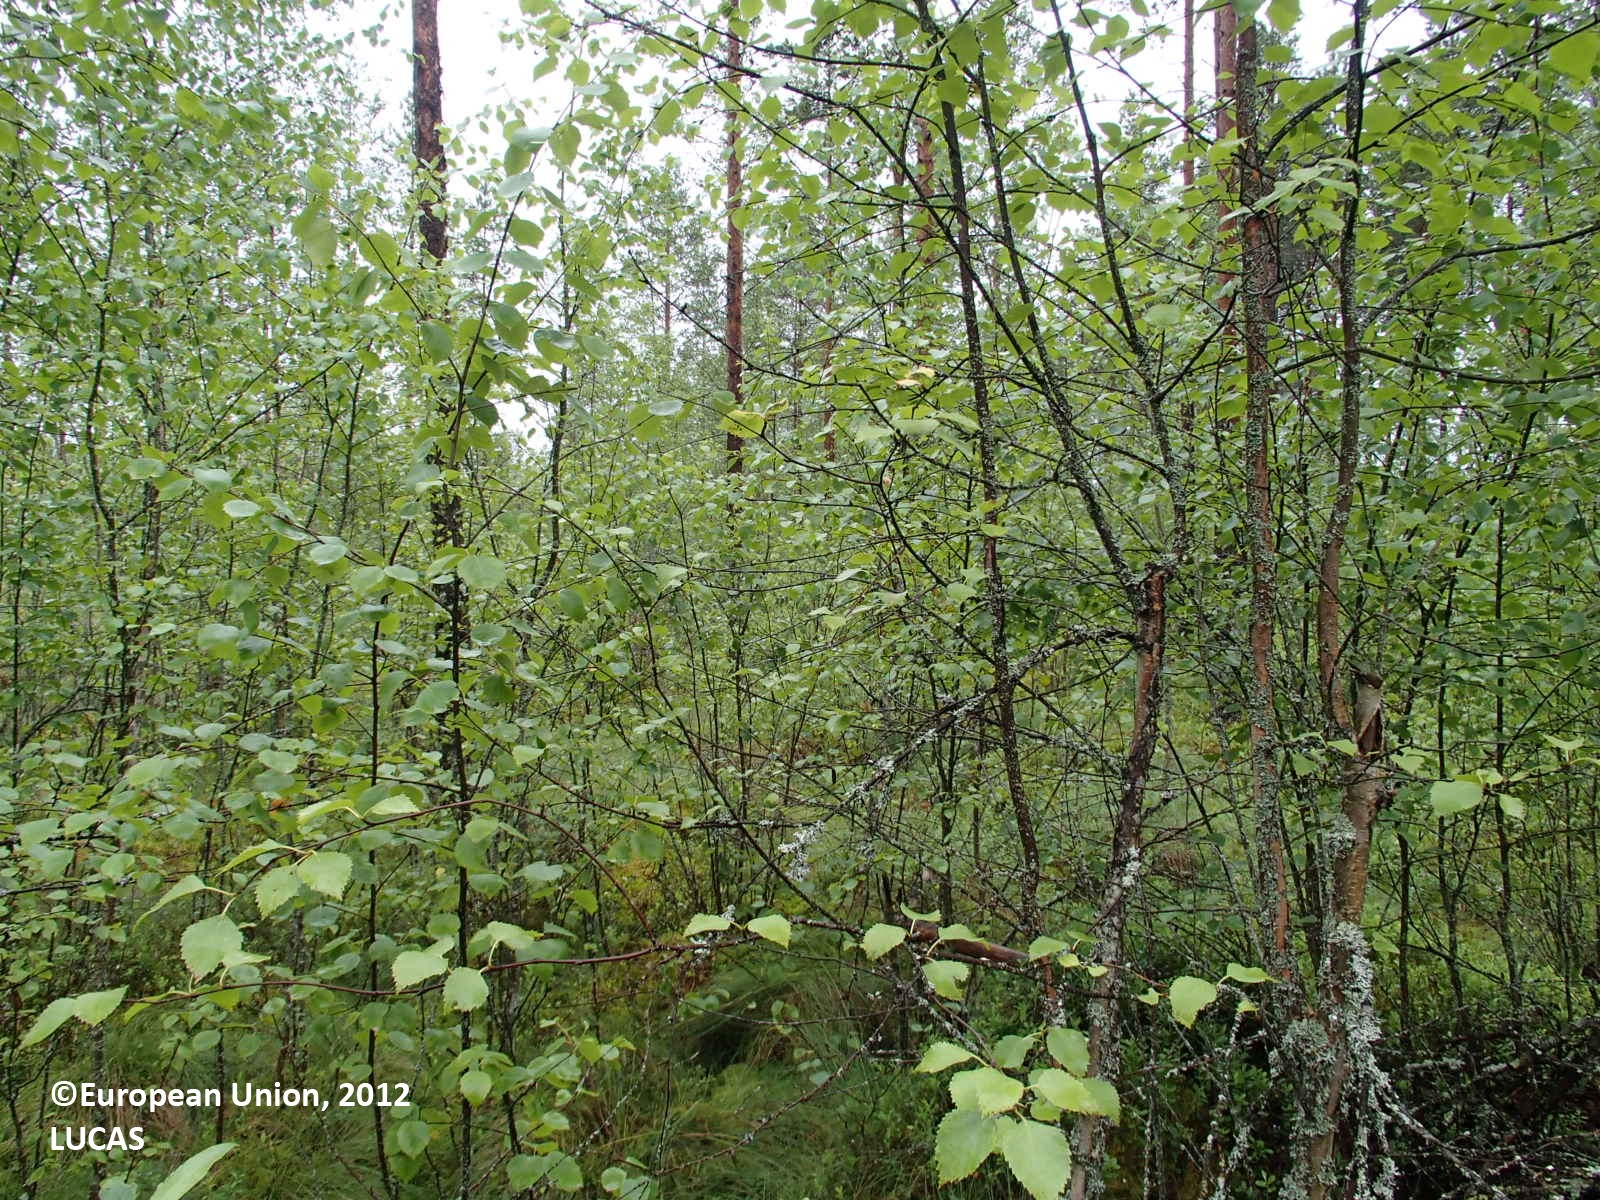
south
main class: Woodland
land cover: Pine dominated mixed woodland
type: boreal forest
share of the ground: > 75 %
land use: Forestry
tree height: > 5 m
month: July
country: FI
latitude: 64.3939
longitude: 26.3499
